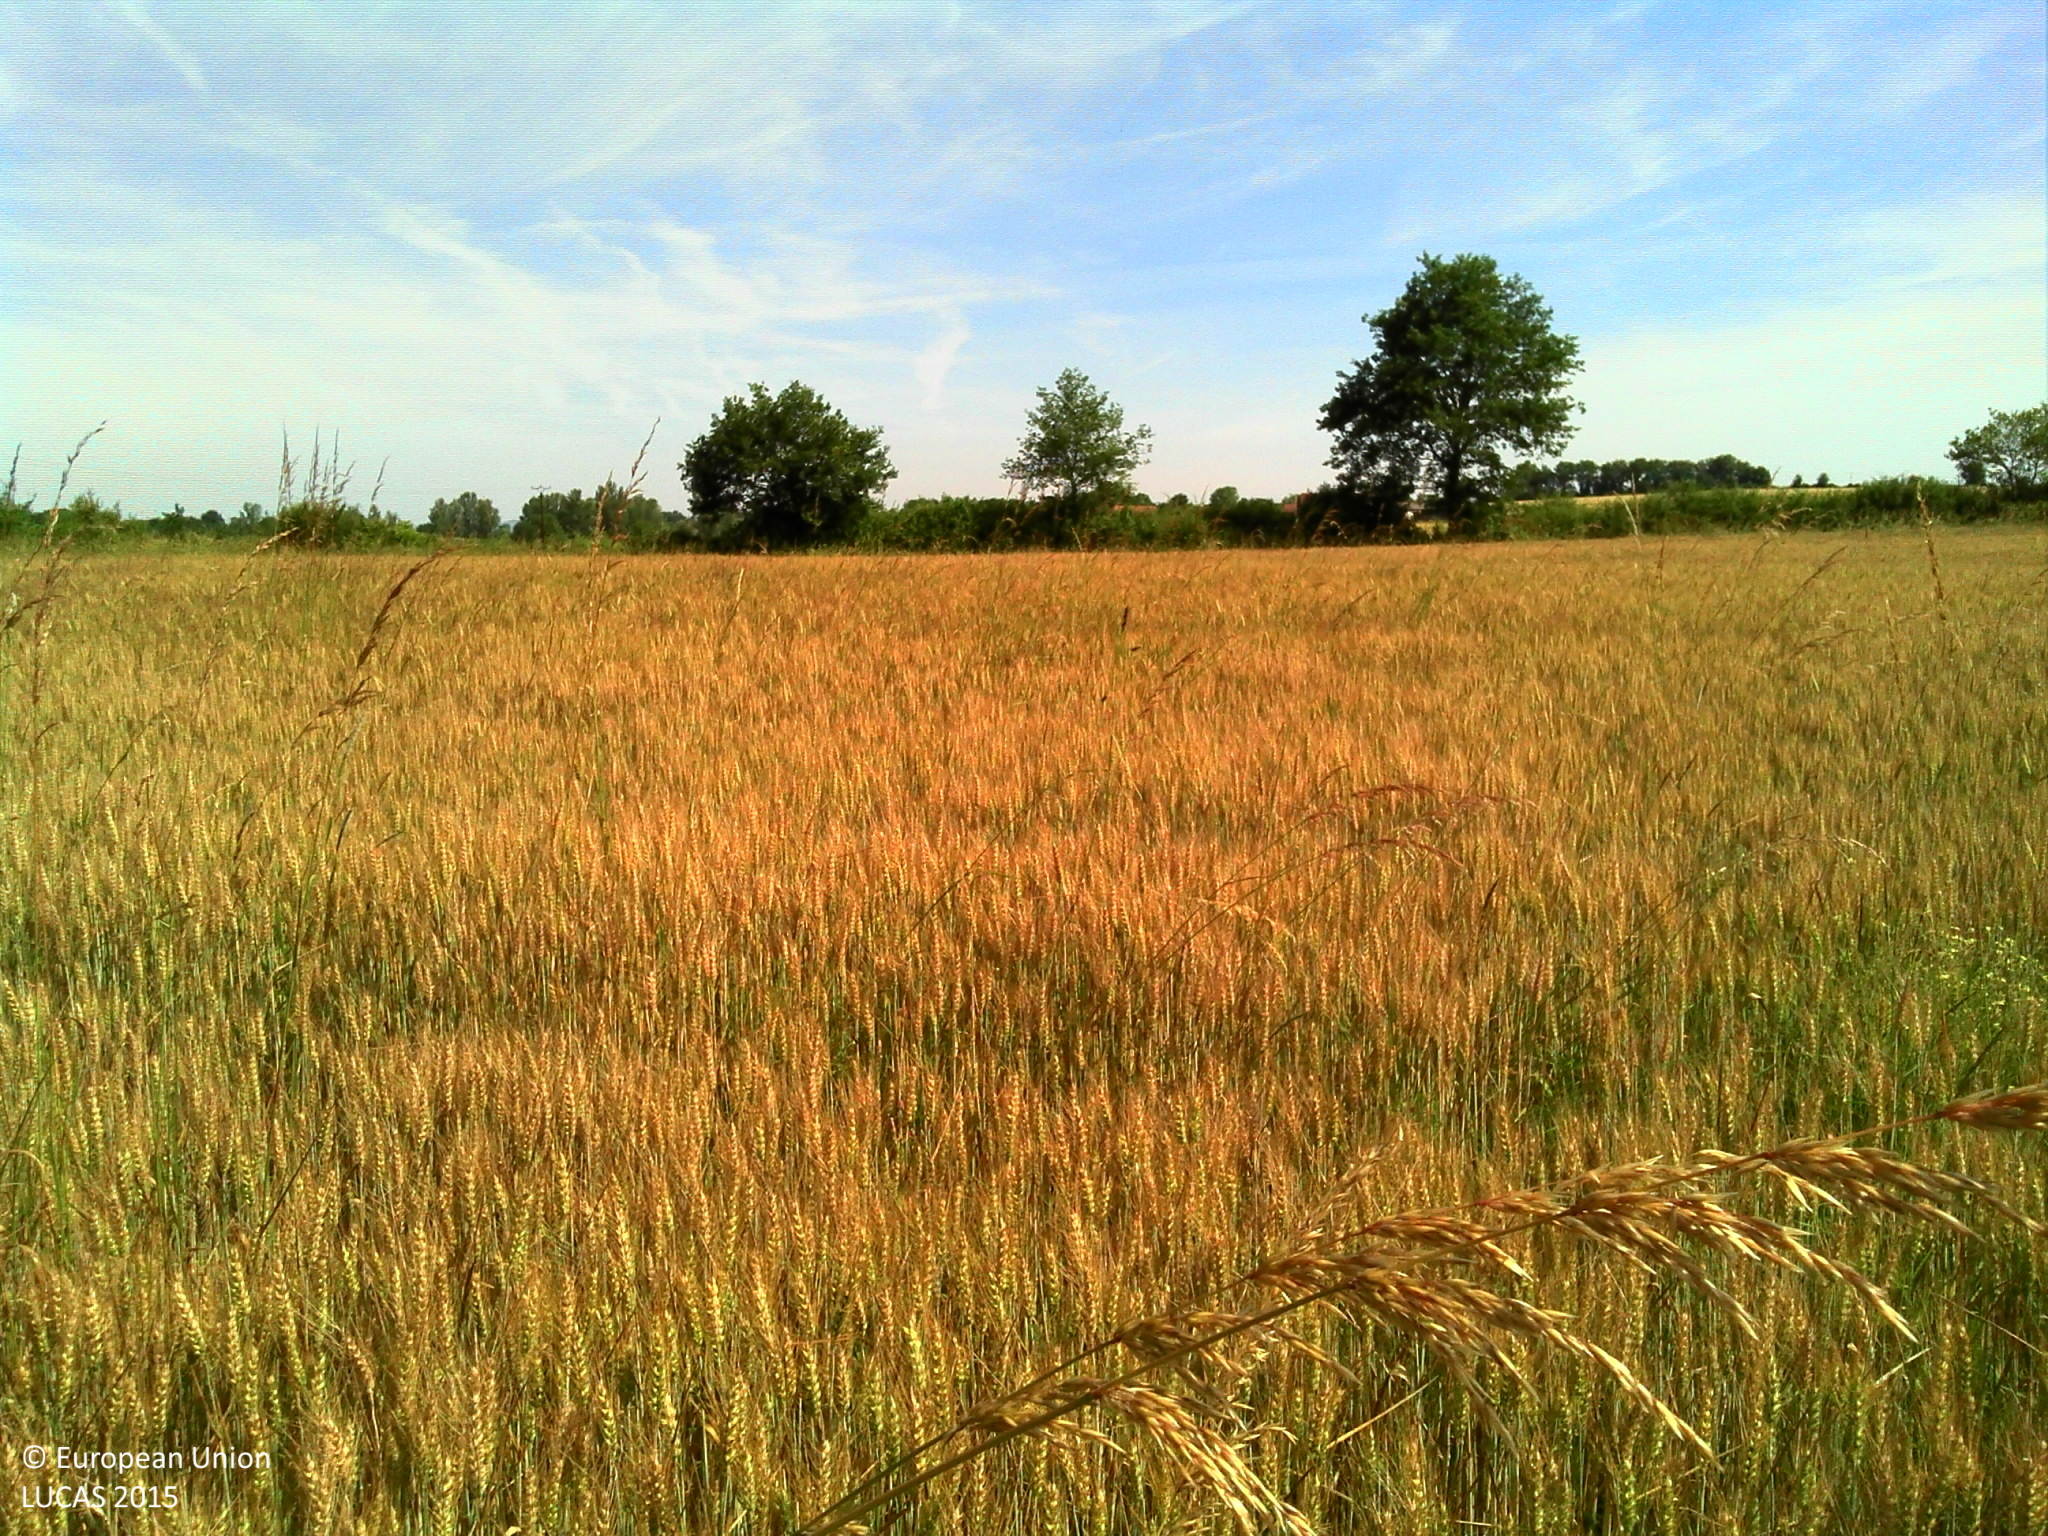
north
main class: Cropland
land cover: Common wheat
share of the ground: > 75 %
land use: Agriculture (excluding fallow land and kitchen gardens)
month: June
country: FR
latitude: 44.4954
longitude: 2.0149
